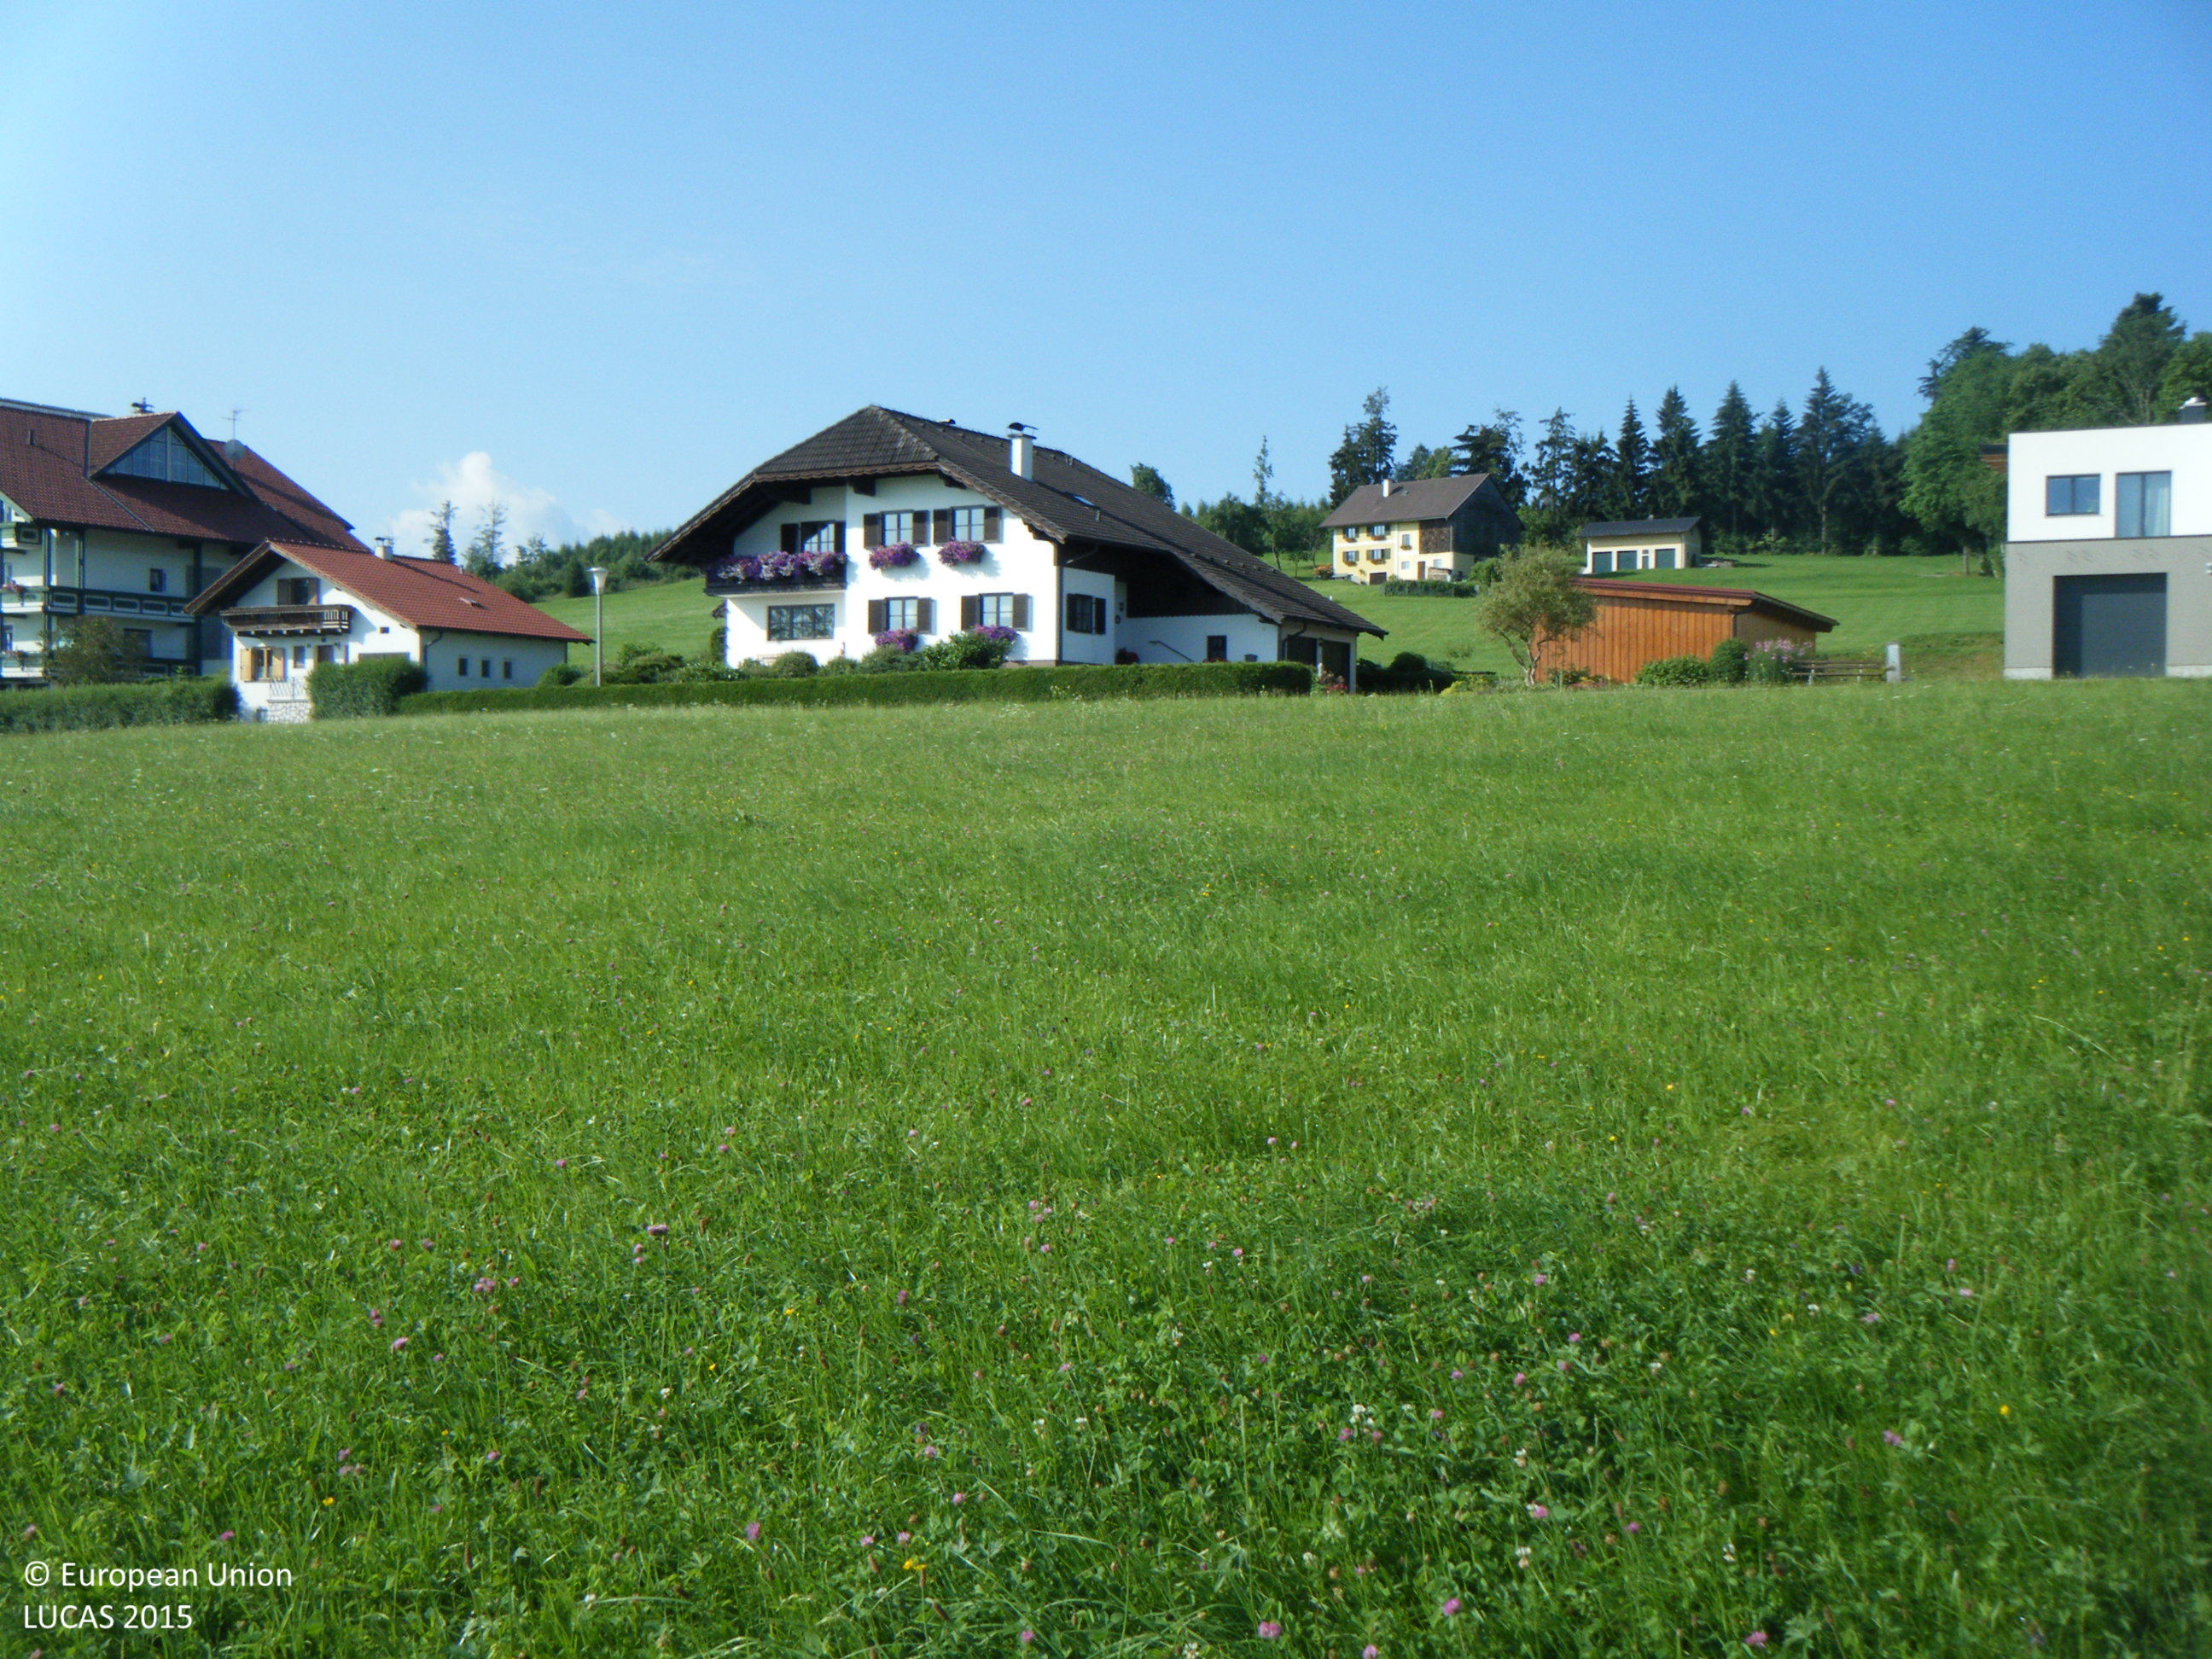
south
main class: Grassland
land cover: Grassland without tree/shrub cover
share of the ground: > 75 %
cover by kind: herbaceous plants 100 %
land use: Agriculture (excluding fallow land and kitchen gardens)
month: July
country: AT
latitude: 47.8981
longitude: 13.4901
